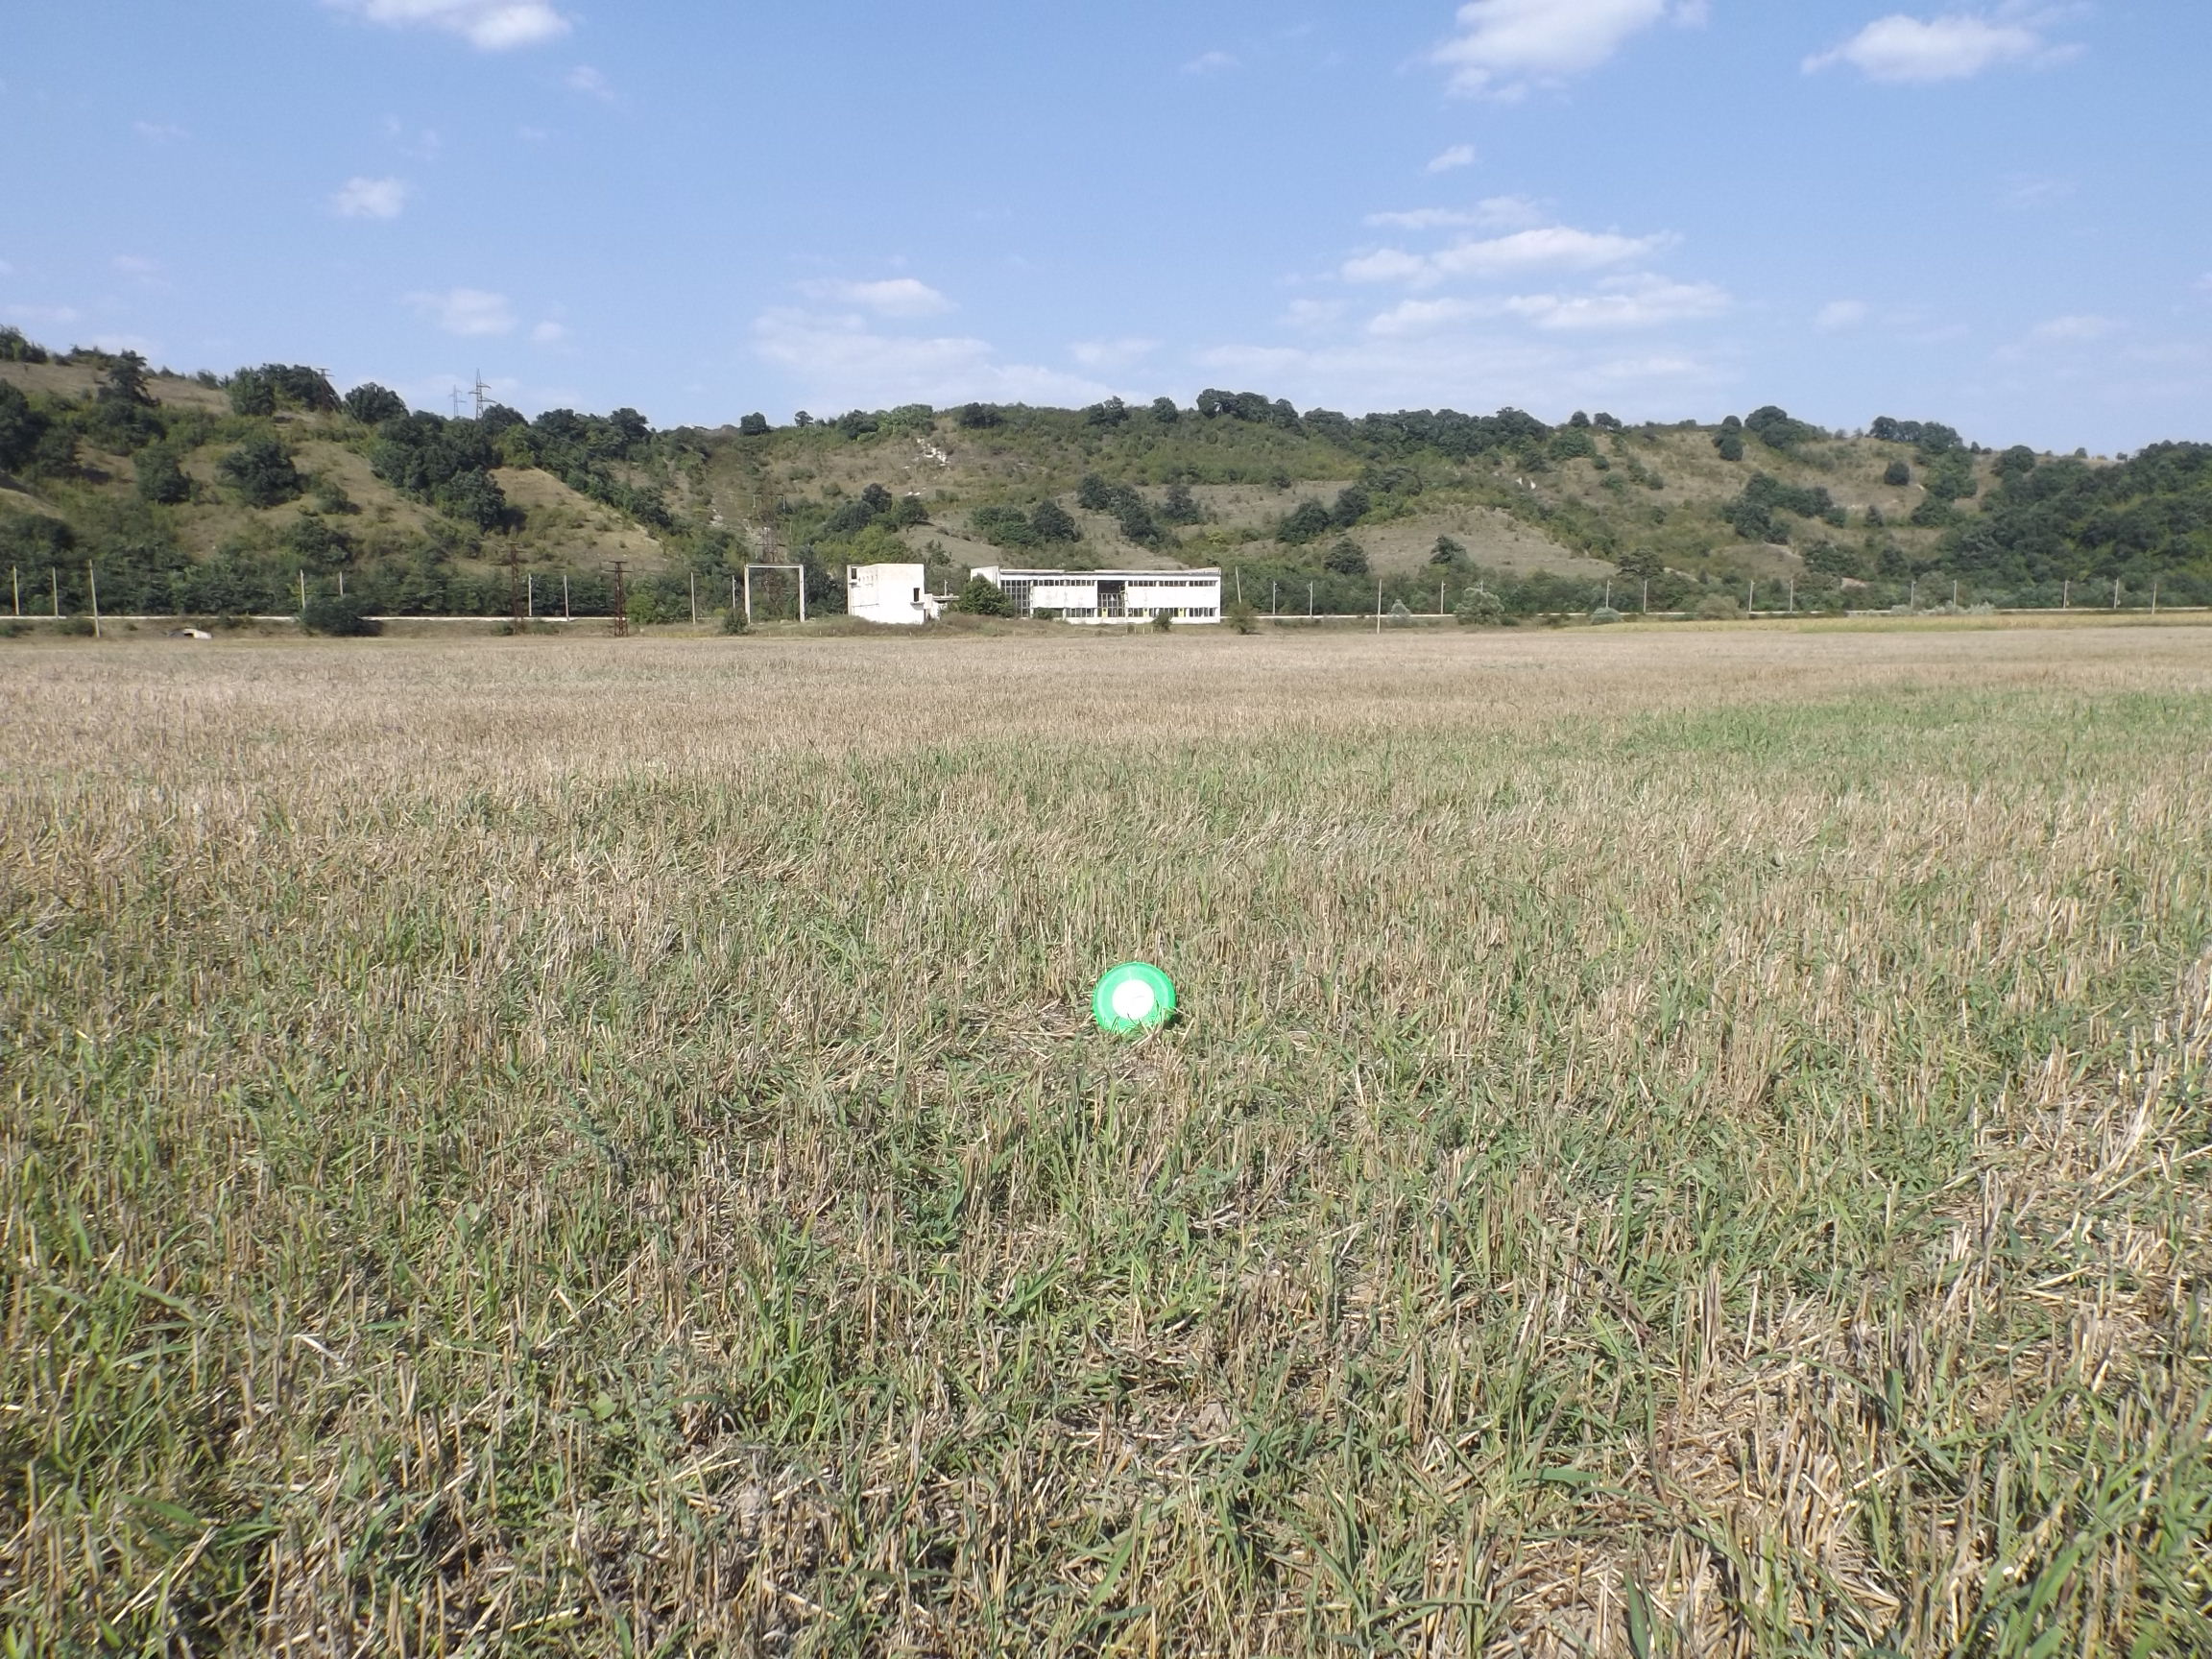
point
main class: Cropland
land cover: Common wheat
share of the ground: 25 - 50 %
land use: Agriculture (excluding fallow land and kitchen gardens)
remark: Harvested field
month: August
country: BG
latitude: 43.0515
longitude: 27.3961
